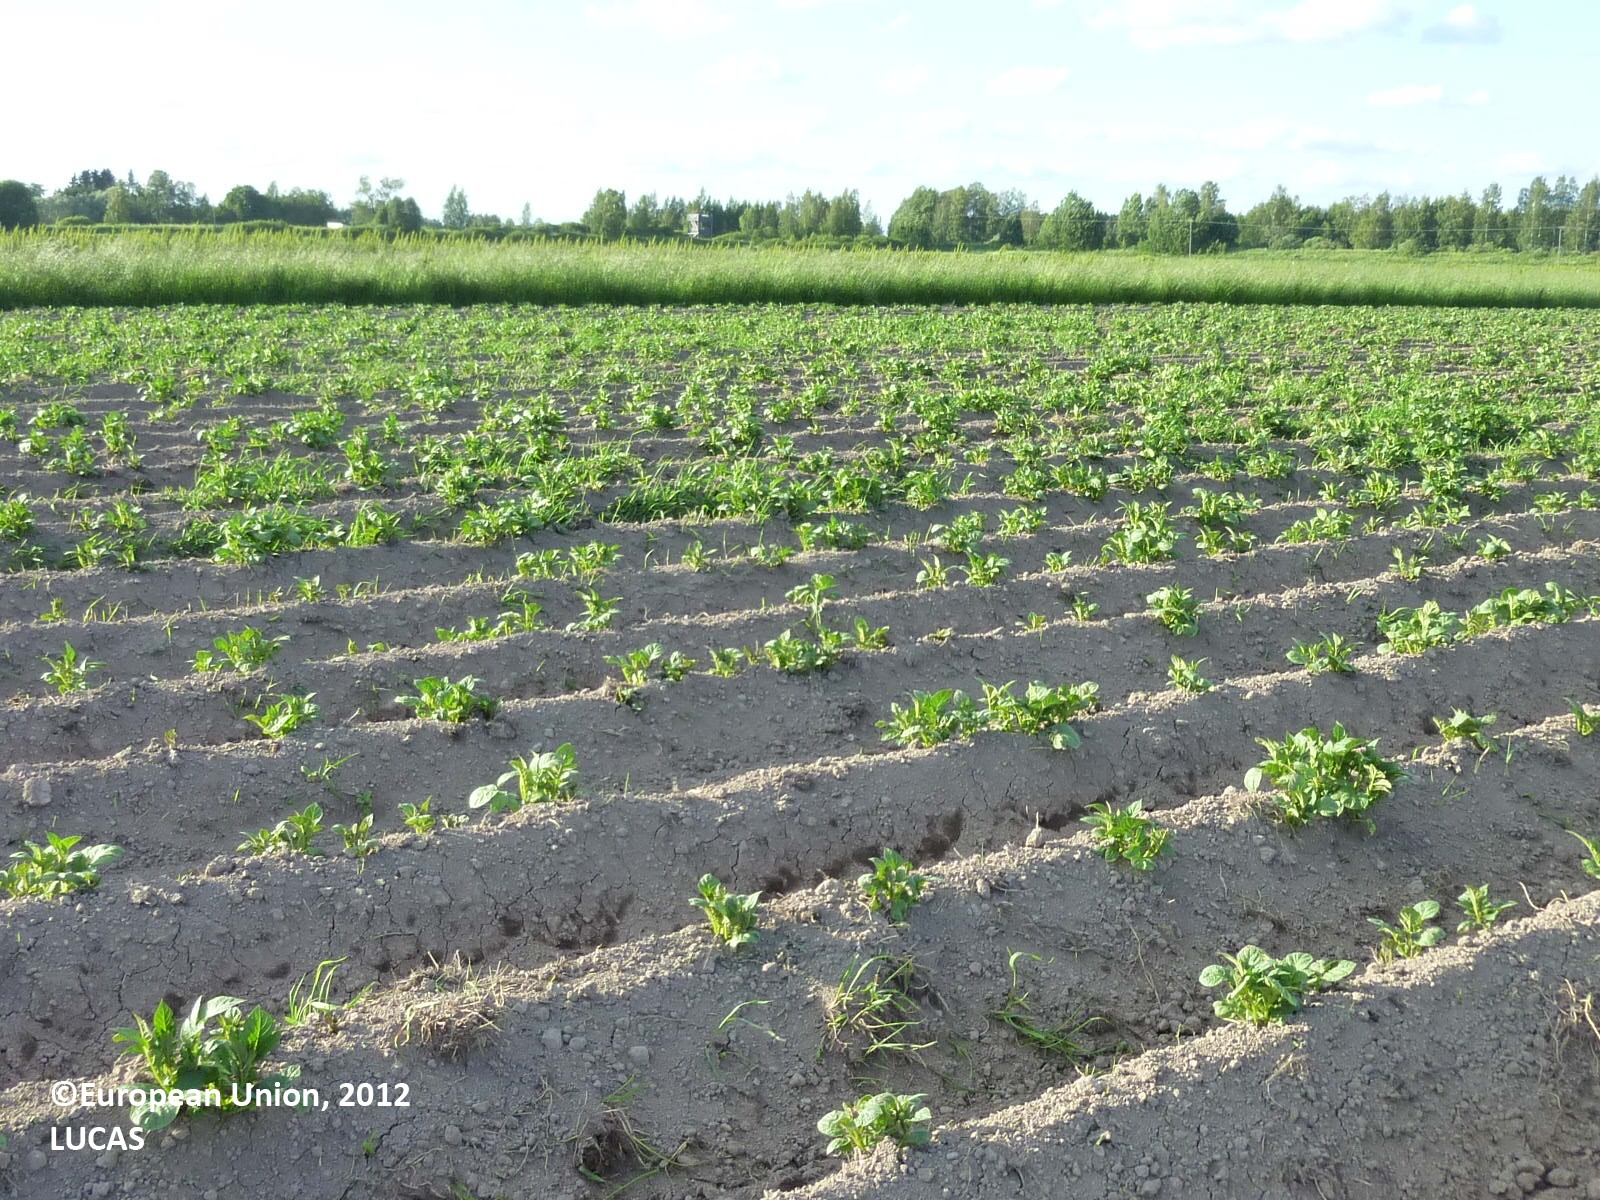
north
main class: Cropland
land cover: Potatoes
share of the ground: 10 - 25 %
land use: Agriculture (excluding fallow land and kitchen gardens)
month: July
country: FI
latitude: 61.2065
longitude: 22.5548
